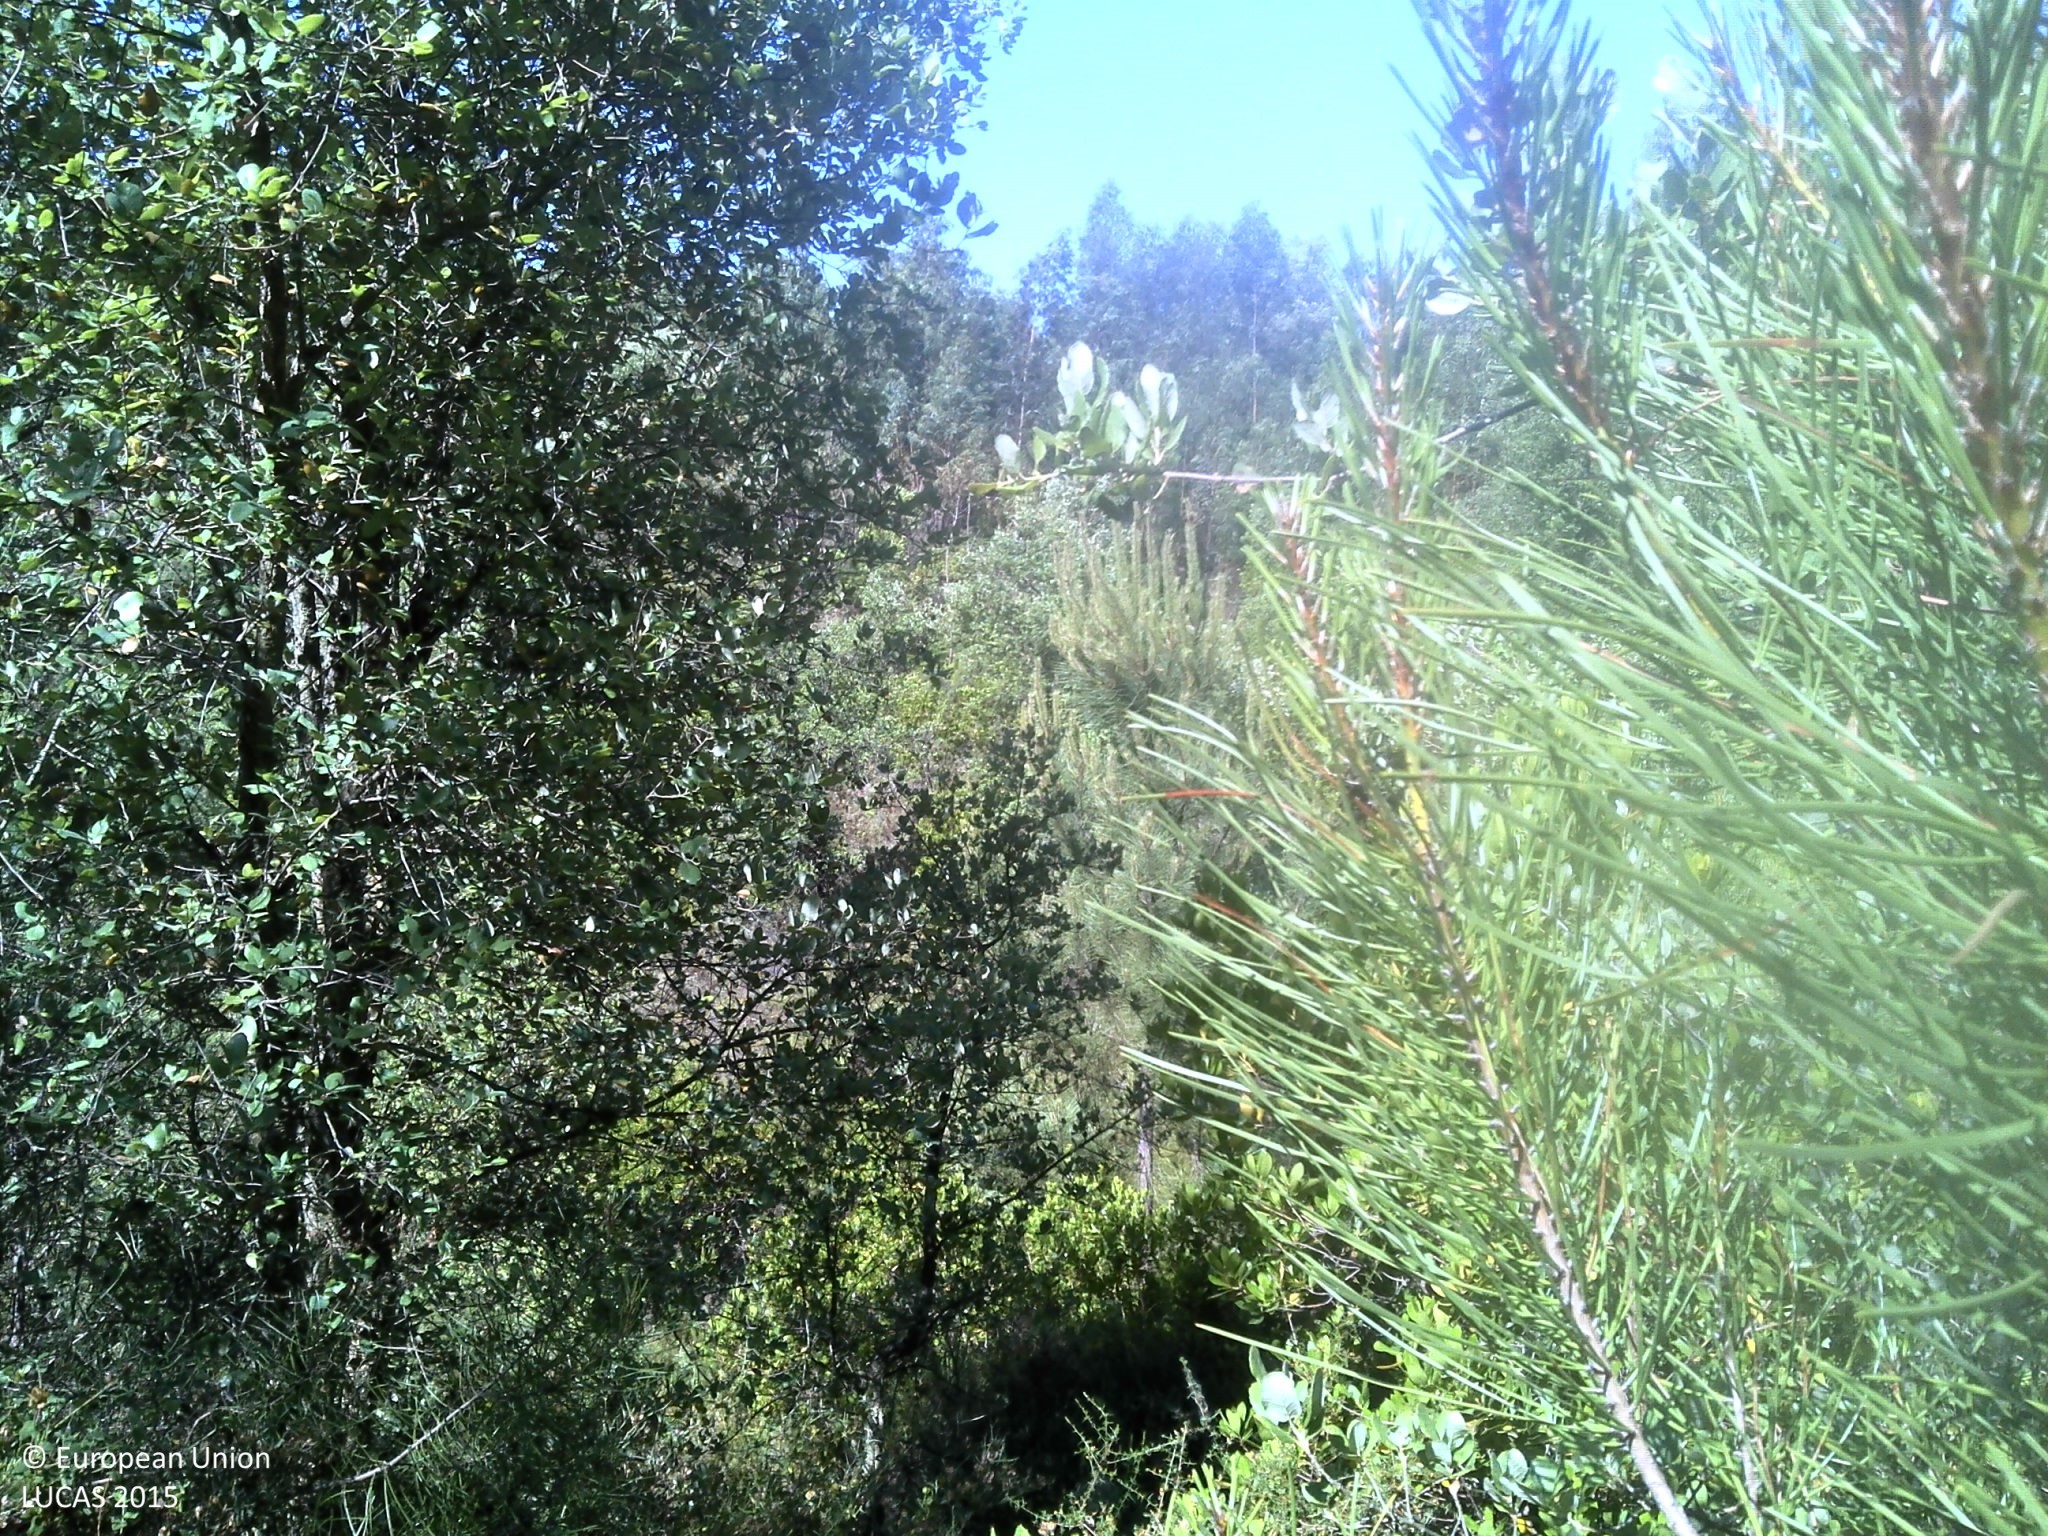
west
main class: Woodland
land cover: Pine dominated mixed woodland
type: coniferous forest of the mediterranean region
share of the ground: 25 - 50 %
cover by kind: coniferous forest trees 50 %, broadleaved forest trees 20 %, shrubs 15 %, unconsolidated bare surface 10 %, herbaceous plants 5 %
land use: Forestry
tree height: > 5 m
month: May
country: PT
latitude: 39.3449
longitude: -8.3880
